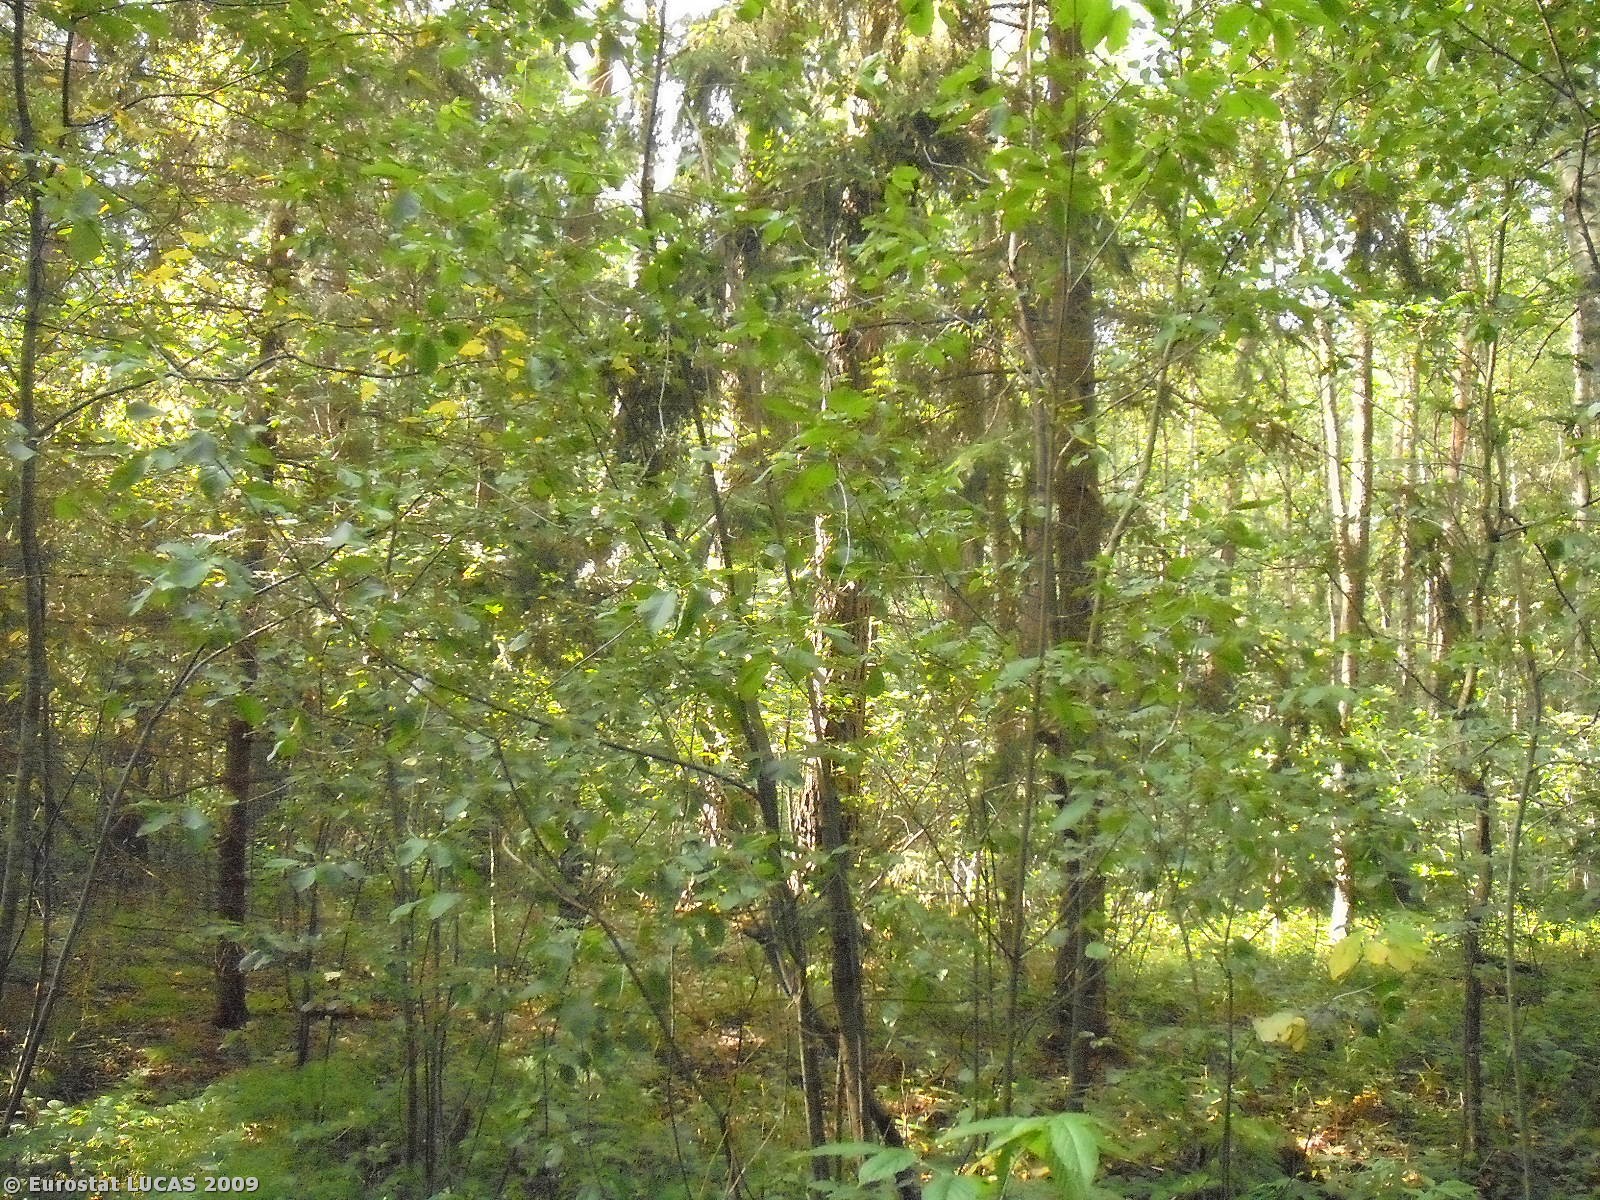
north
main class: Woodland
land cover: Mixed woodland
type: mesophytic deciduous forest
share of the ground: > 75 %
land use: Forestry
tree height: > 5 m
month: July
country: PL
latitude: 50.7174
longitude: 20.8492
